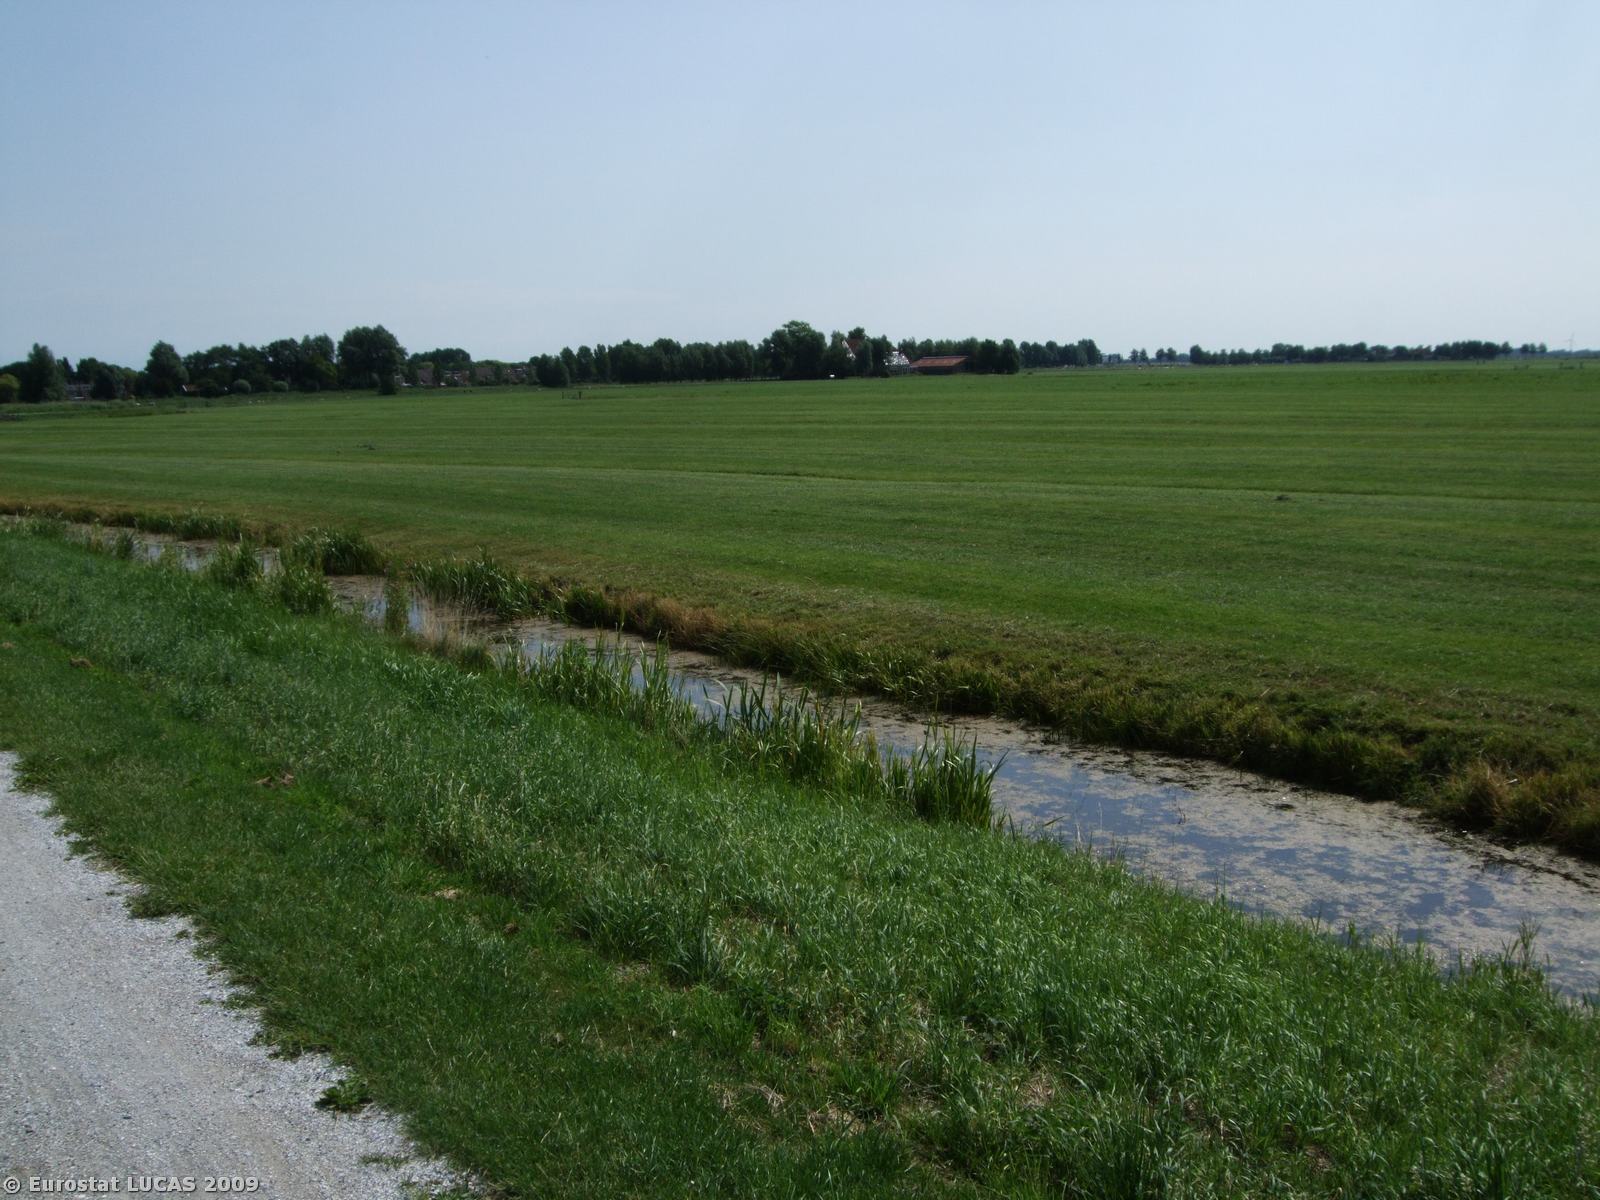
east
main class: Wetlands
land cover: Inland marshes
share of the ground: > 75 %
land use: Unused
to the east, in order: Inland marshes; Grassland without tree/shrub cover; Inland running water; Grass margins; Tracks; Grassland without tree/shrub cover; Ditches and canals; Grassland without tree/shrub cover; Ditches and canals; Grassland without tree/shrub cover; Ditches and canals
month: May
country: NL
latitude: 53.0172
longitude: 5.6313
